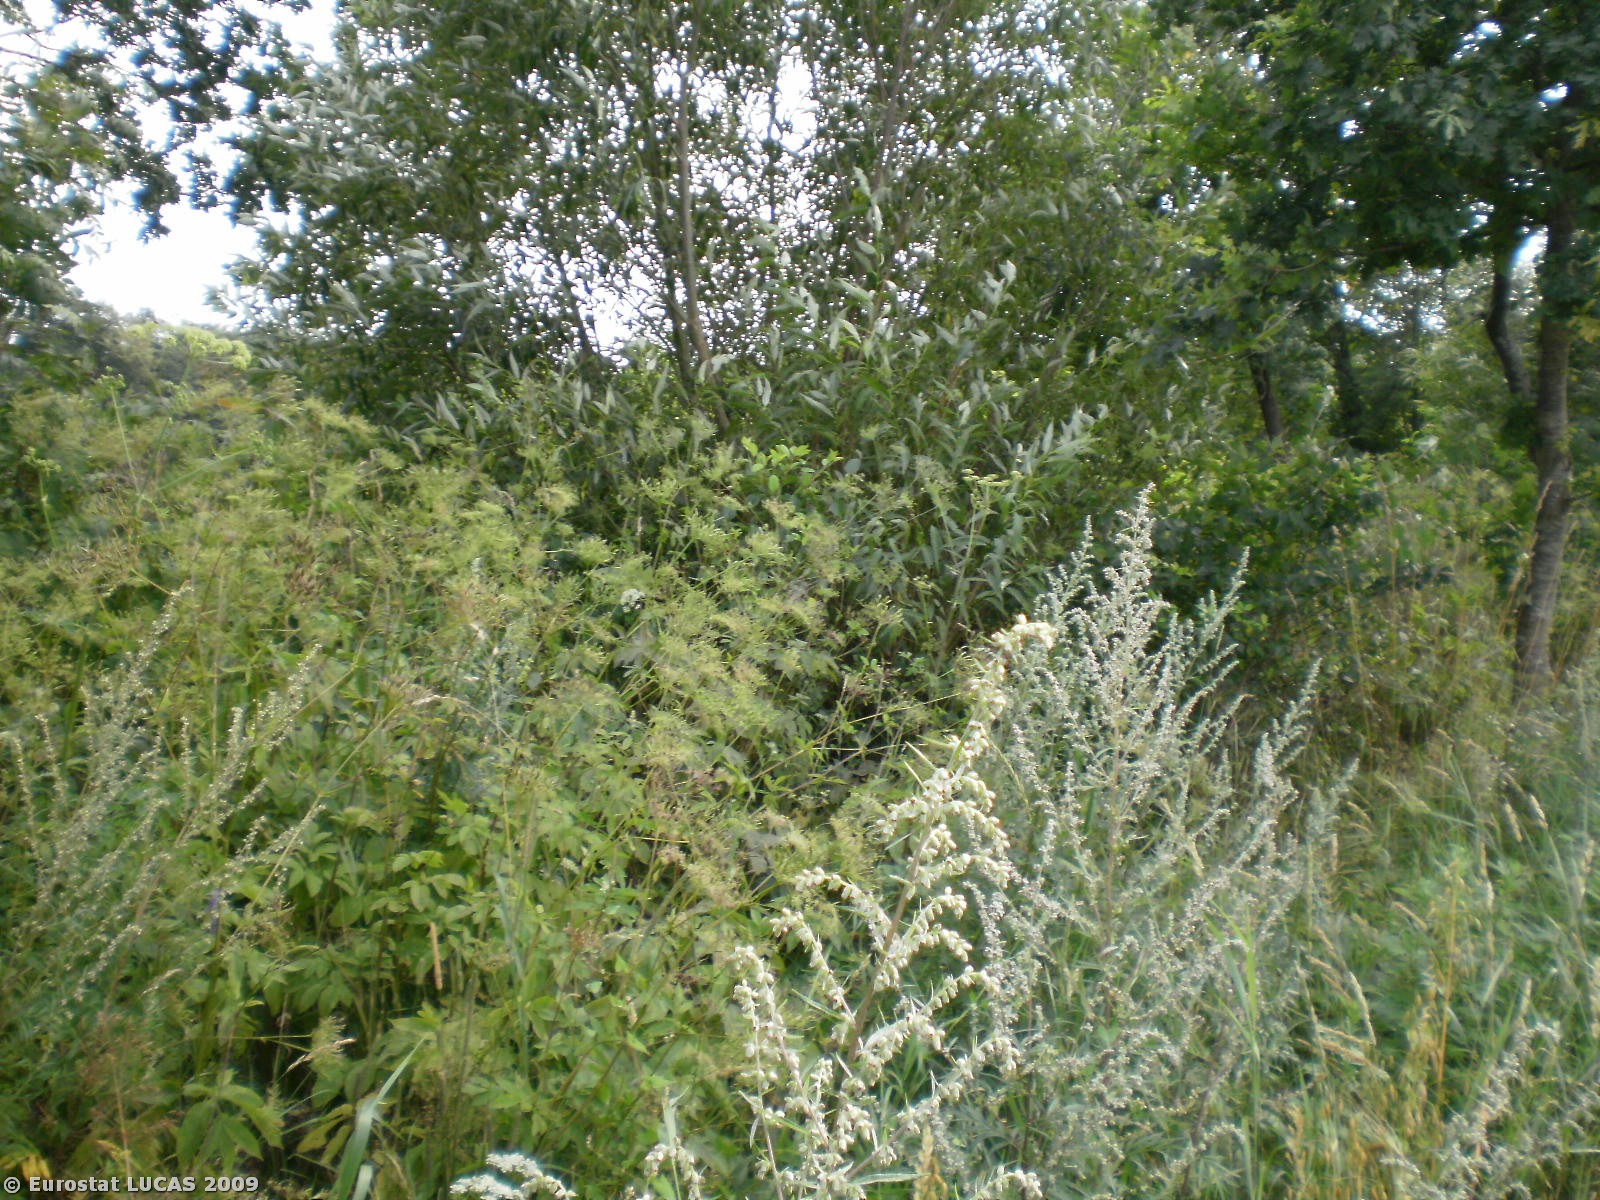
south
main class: Cropland
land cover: Mixed cereals for fodder
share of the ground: > 75 %
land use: Agriculture (excluding fallow land and kitchen gardens)
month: August
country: PL
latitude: 54.2651
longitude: 19.6537
